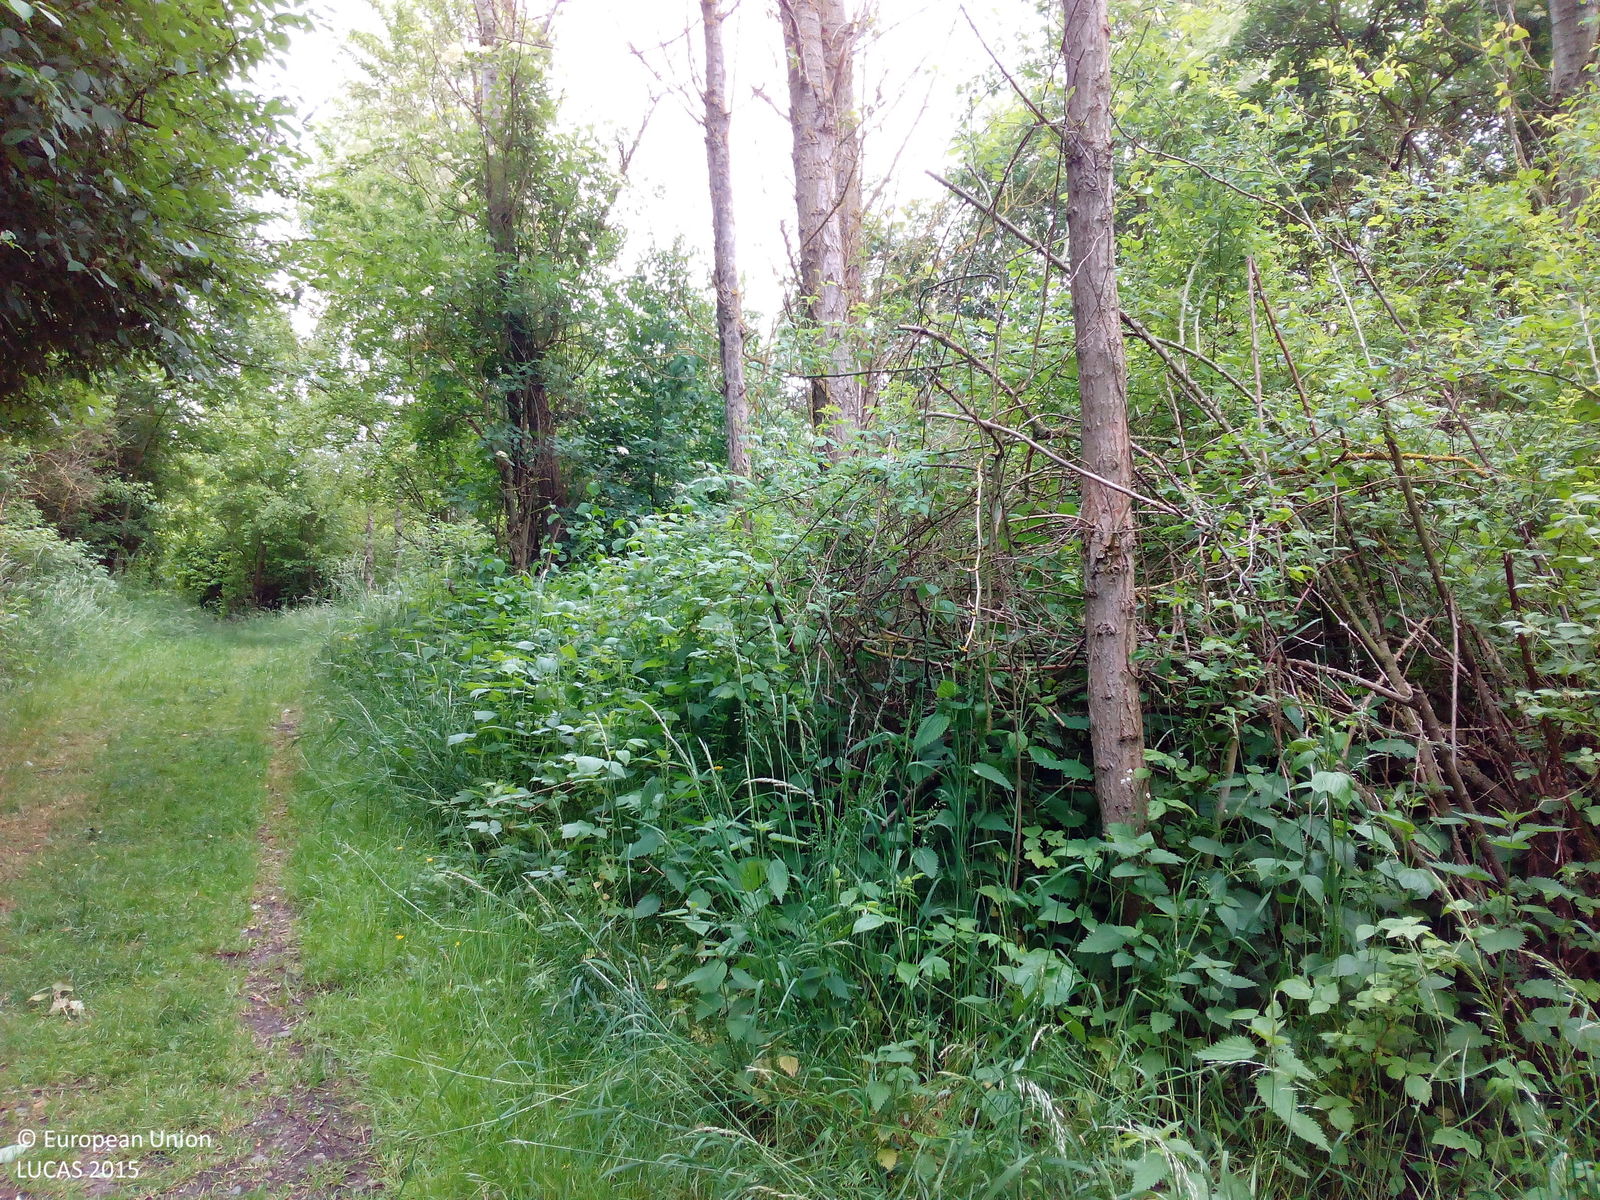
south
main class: Woodland
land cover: Broadleaved woodland
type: beech forest
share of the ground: > 75 %
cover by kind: broadleaved forest trees 100 %
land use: Forestry
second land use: Amenities, museums, leisure
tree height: > 5 m
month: June
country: DE
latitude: 52.0346
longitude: 10.5683
